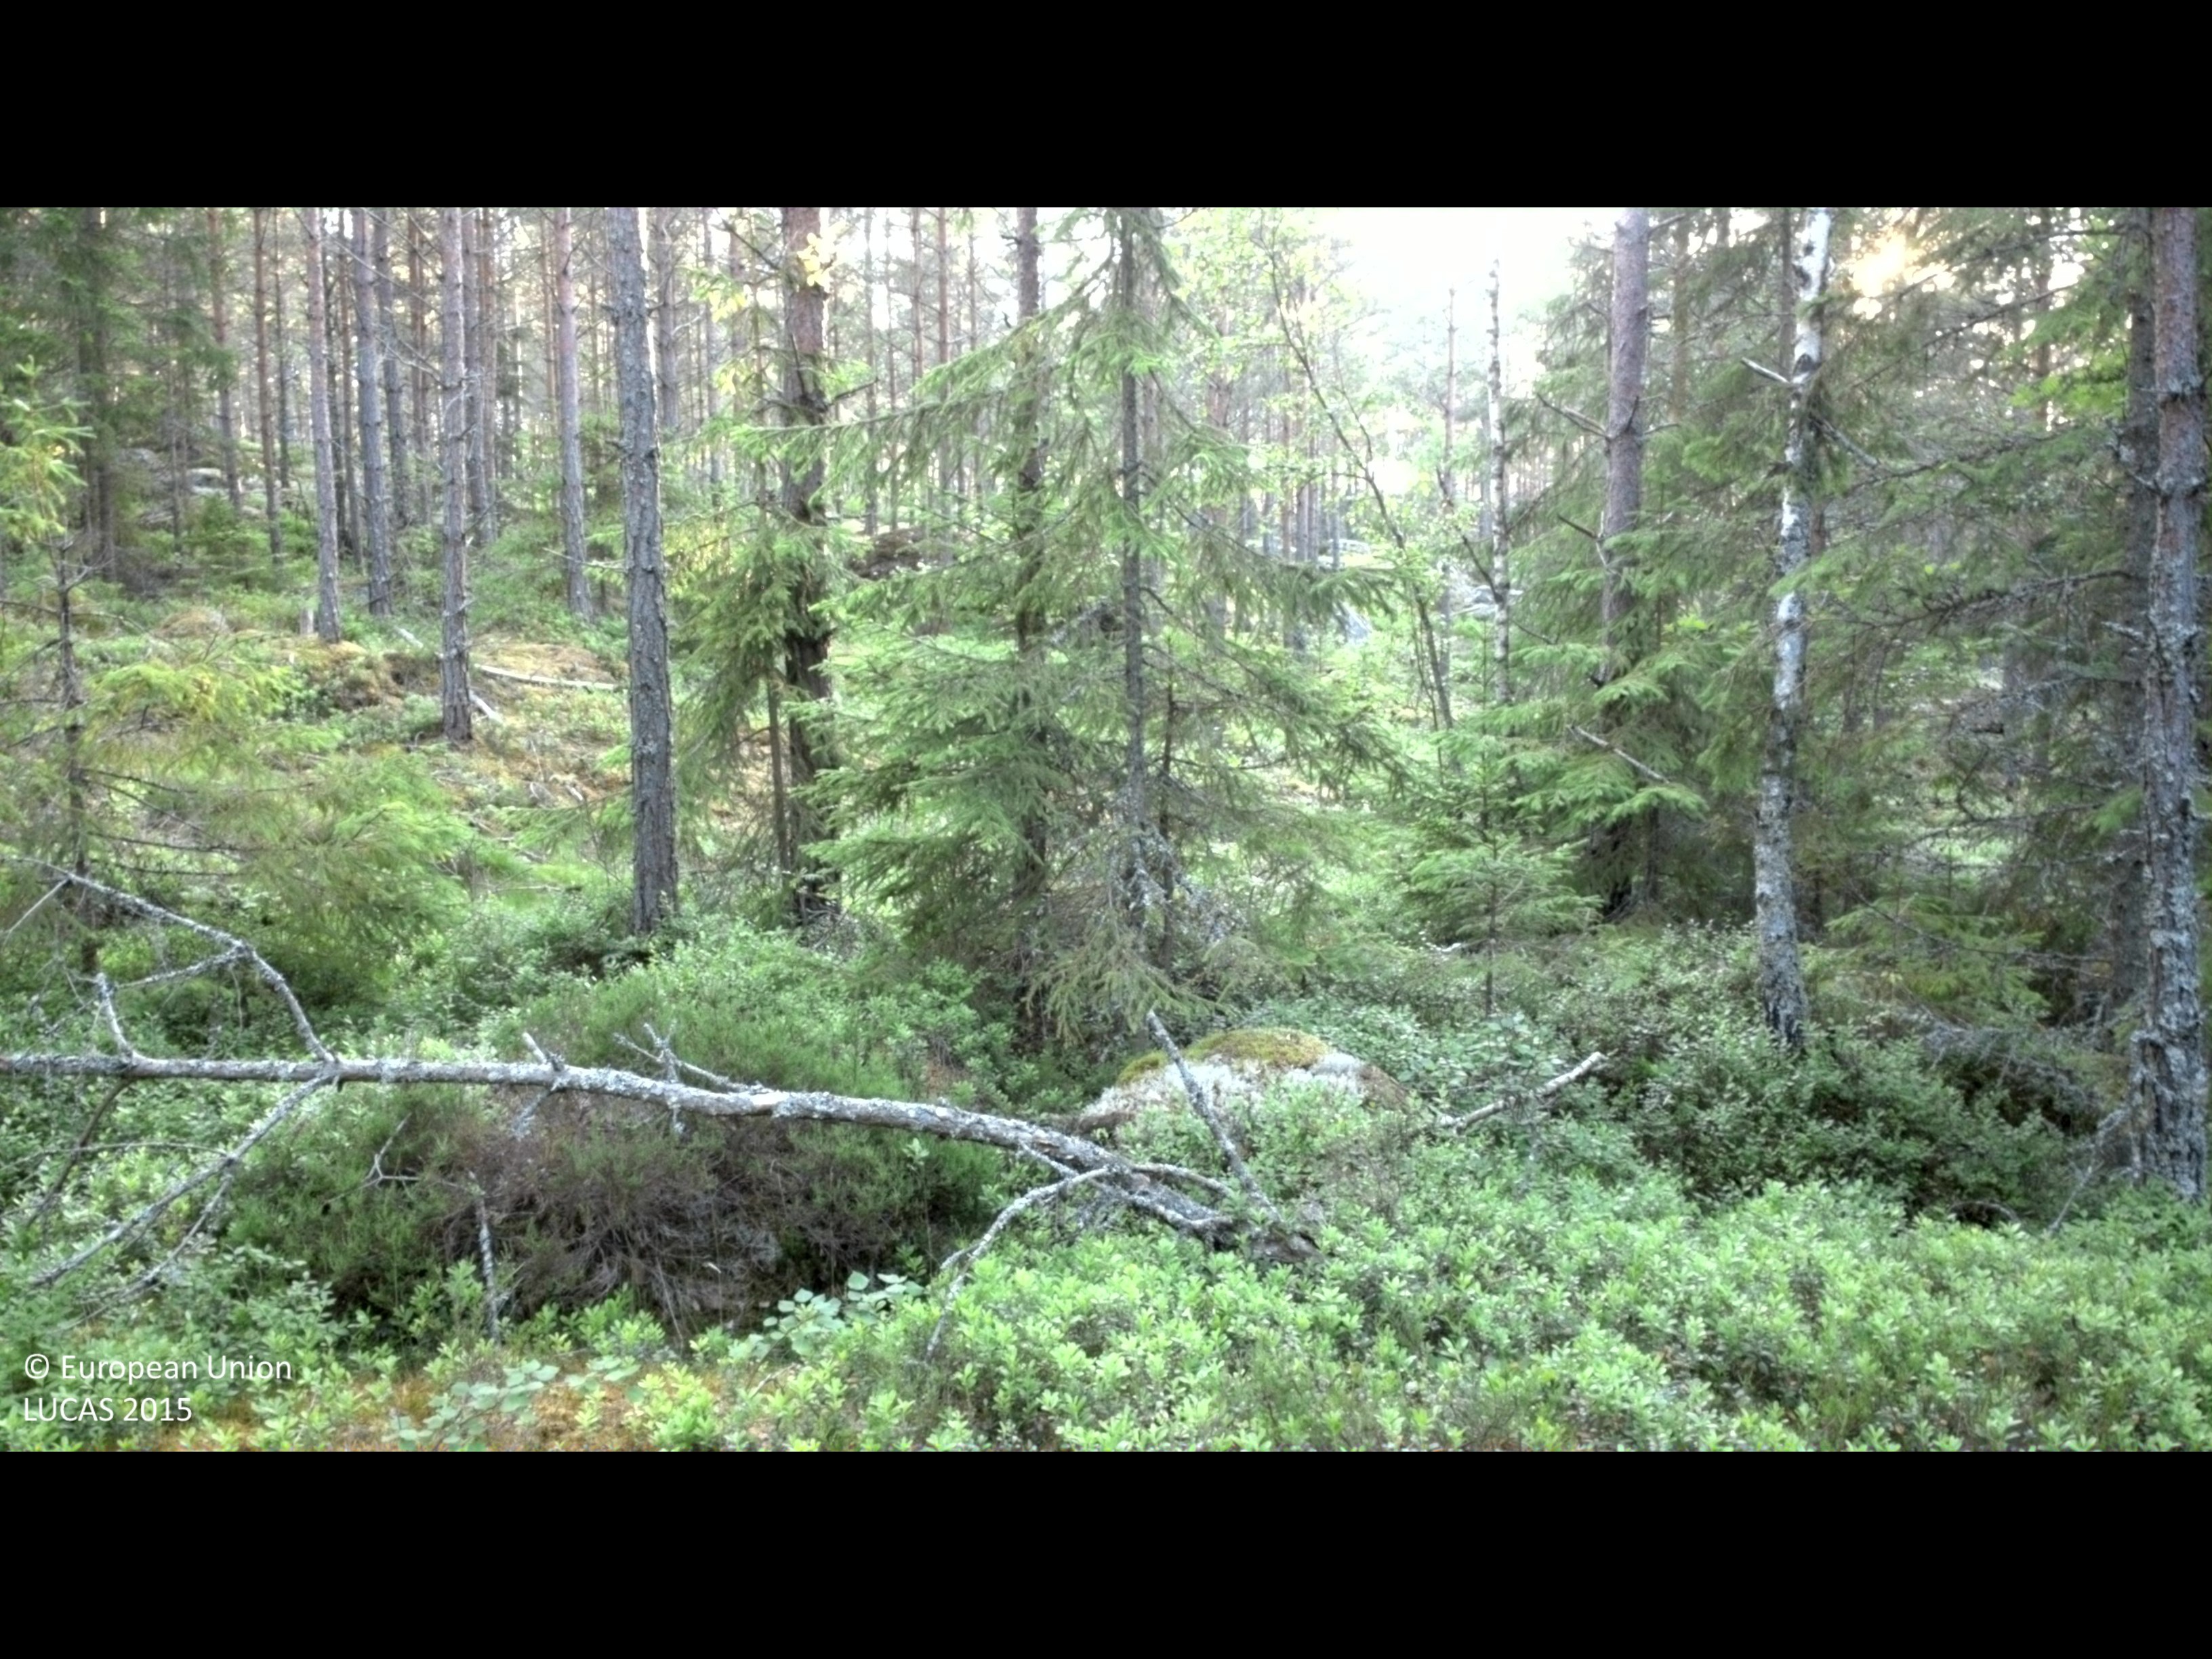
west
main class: Woodland
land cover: Pine dominated coniferous woodland
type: boreal forest
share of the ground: 50 - 75 %
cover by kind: coniferous forest trees 55 %, shrubs 30 %, lichens and mosses 15 %
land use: Forestry
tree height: > 5 m
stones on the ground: < 10 %
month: June
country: SE
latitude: 57.9829
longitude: 16.2712
